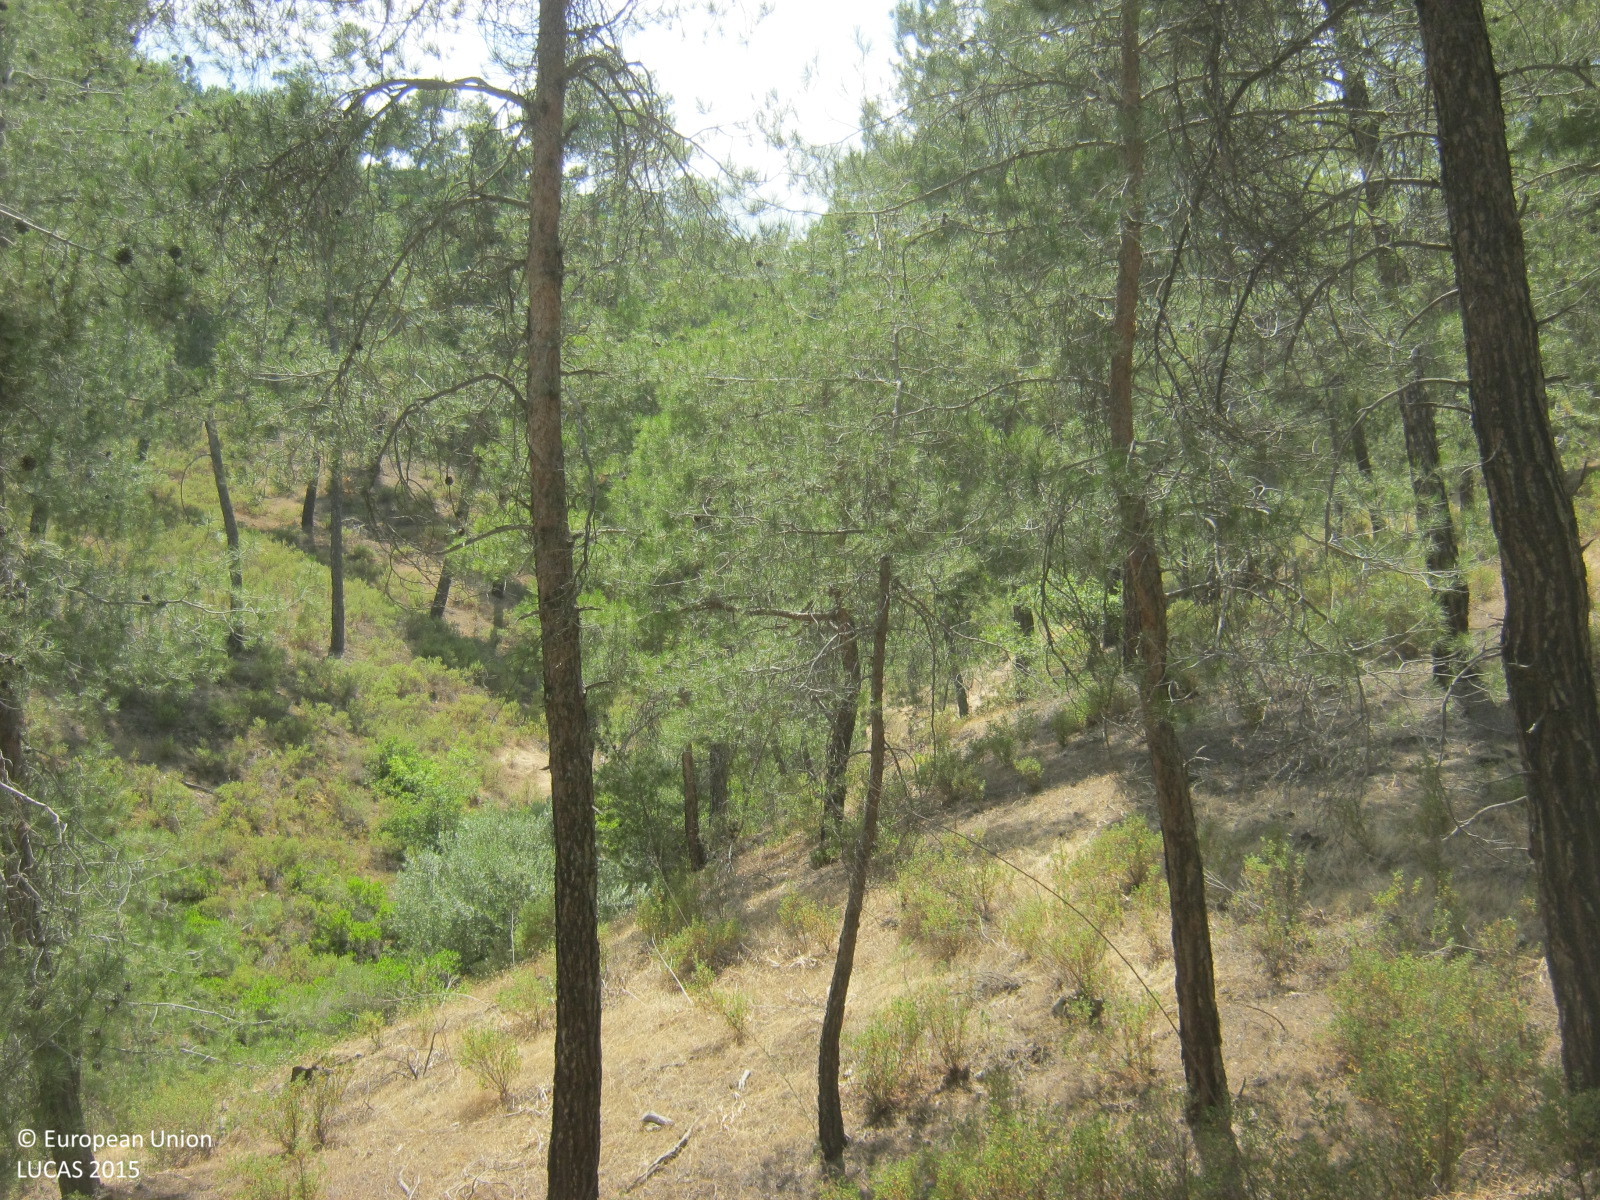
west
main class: Woodland
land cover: Pine dominated coniferous woodland
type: coniferous forest of the mediterranean region
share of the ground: 50 - 75 %
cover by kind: coniferous forest trees 60 %, herbaceous plants 20 %, shrubs 10 %, unconsolidated bare surface 10 %
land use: Forestry
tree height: > 5 m
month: June
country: CY
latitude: 34.9968
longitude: 33.0868
